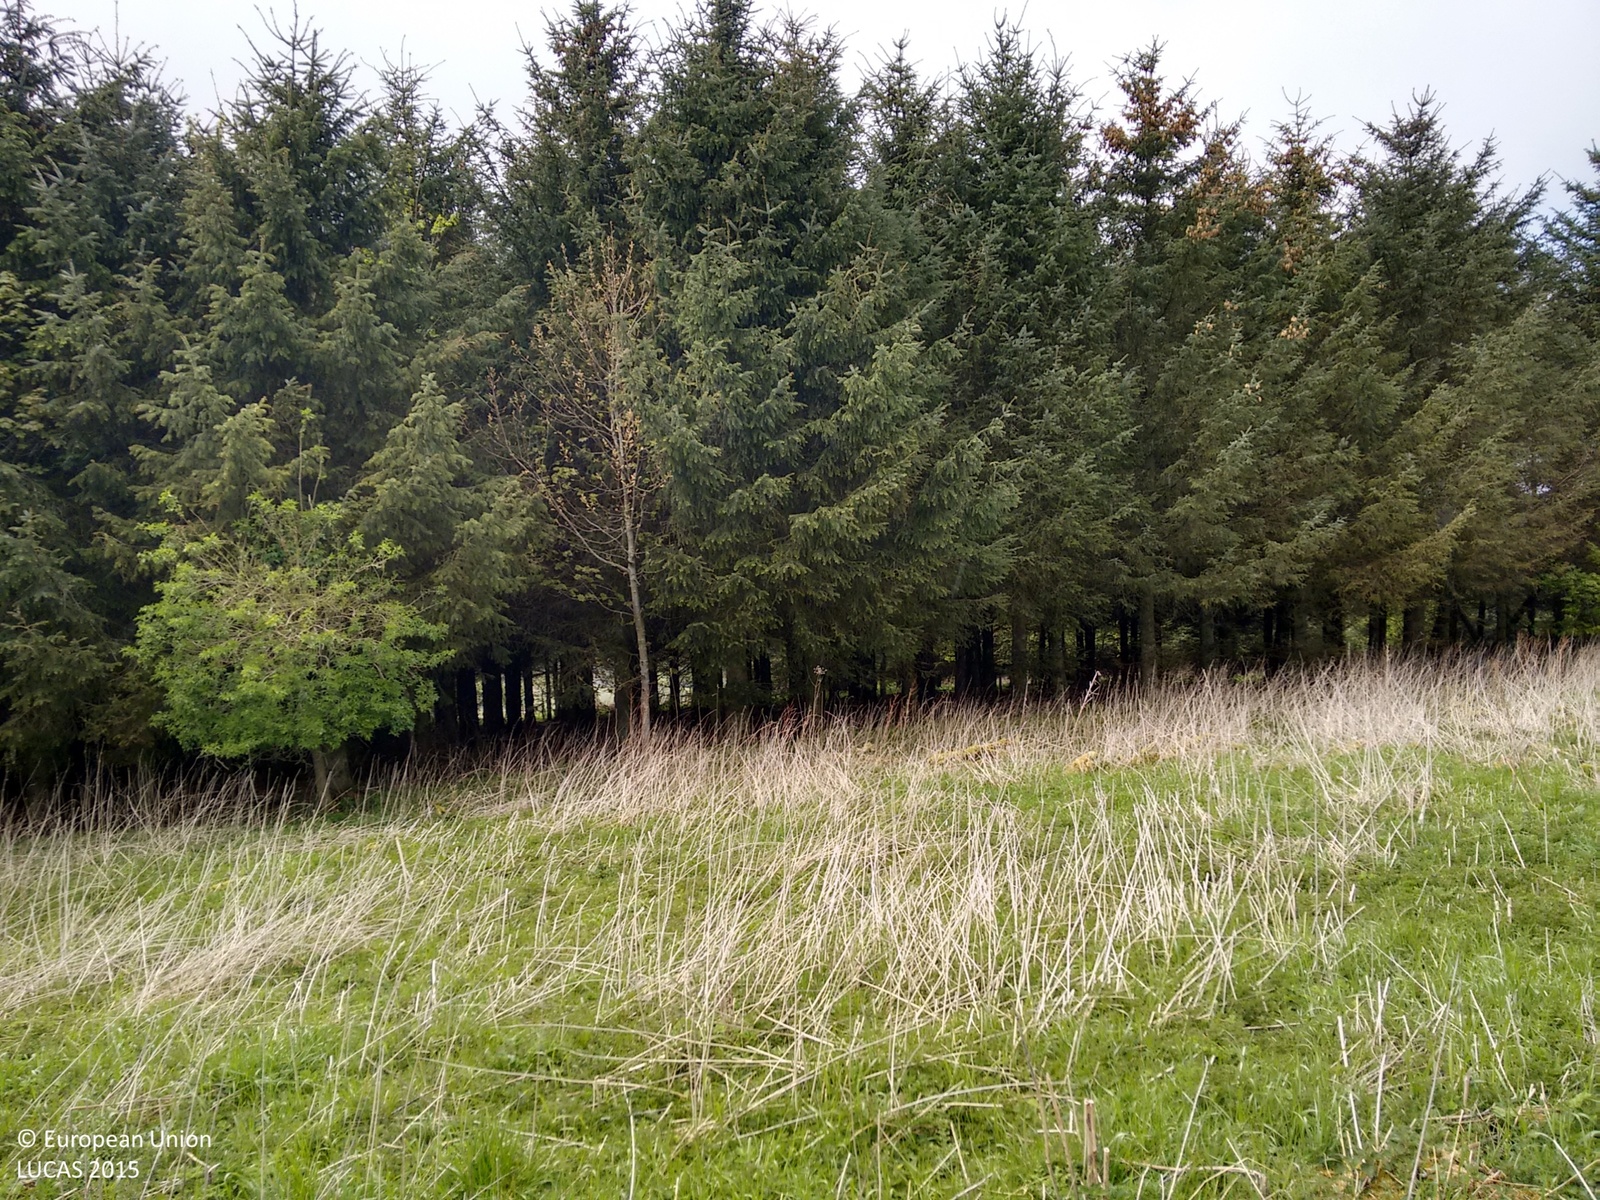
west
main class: Grassland
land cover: Spontaneously vegetated surfaces
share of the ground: > 75 %
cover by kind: herbaceous plants 95 %, shrubs 5 %
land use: Fallow land
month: May
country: GB
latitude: 55.8144
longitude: -2.4588
